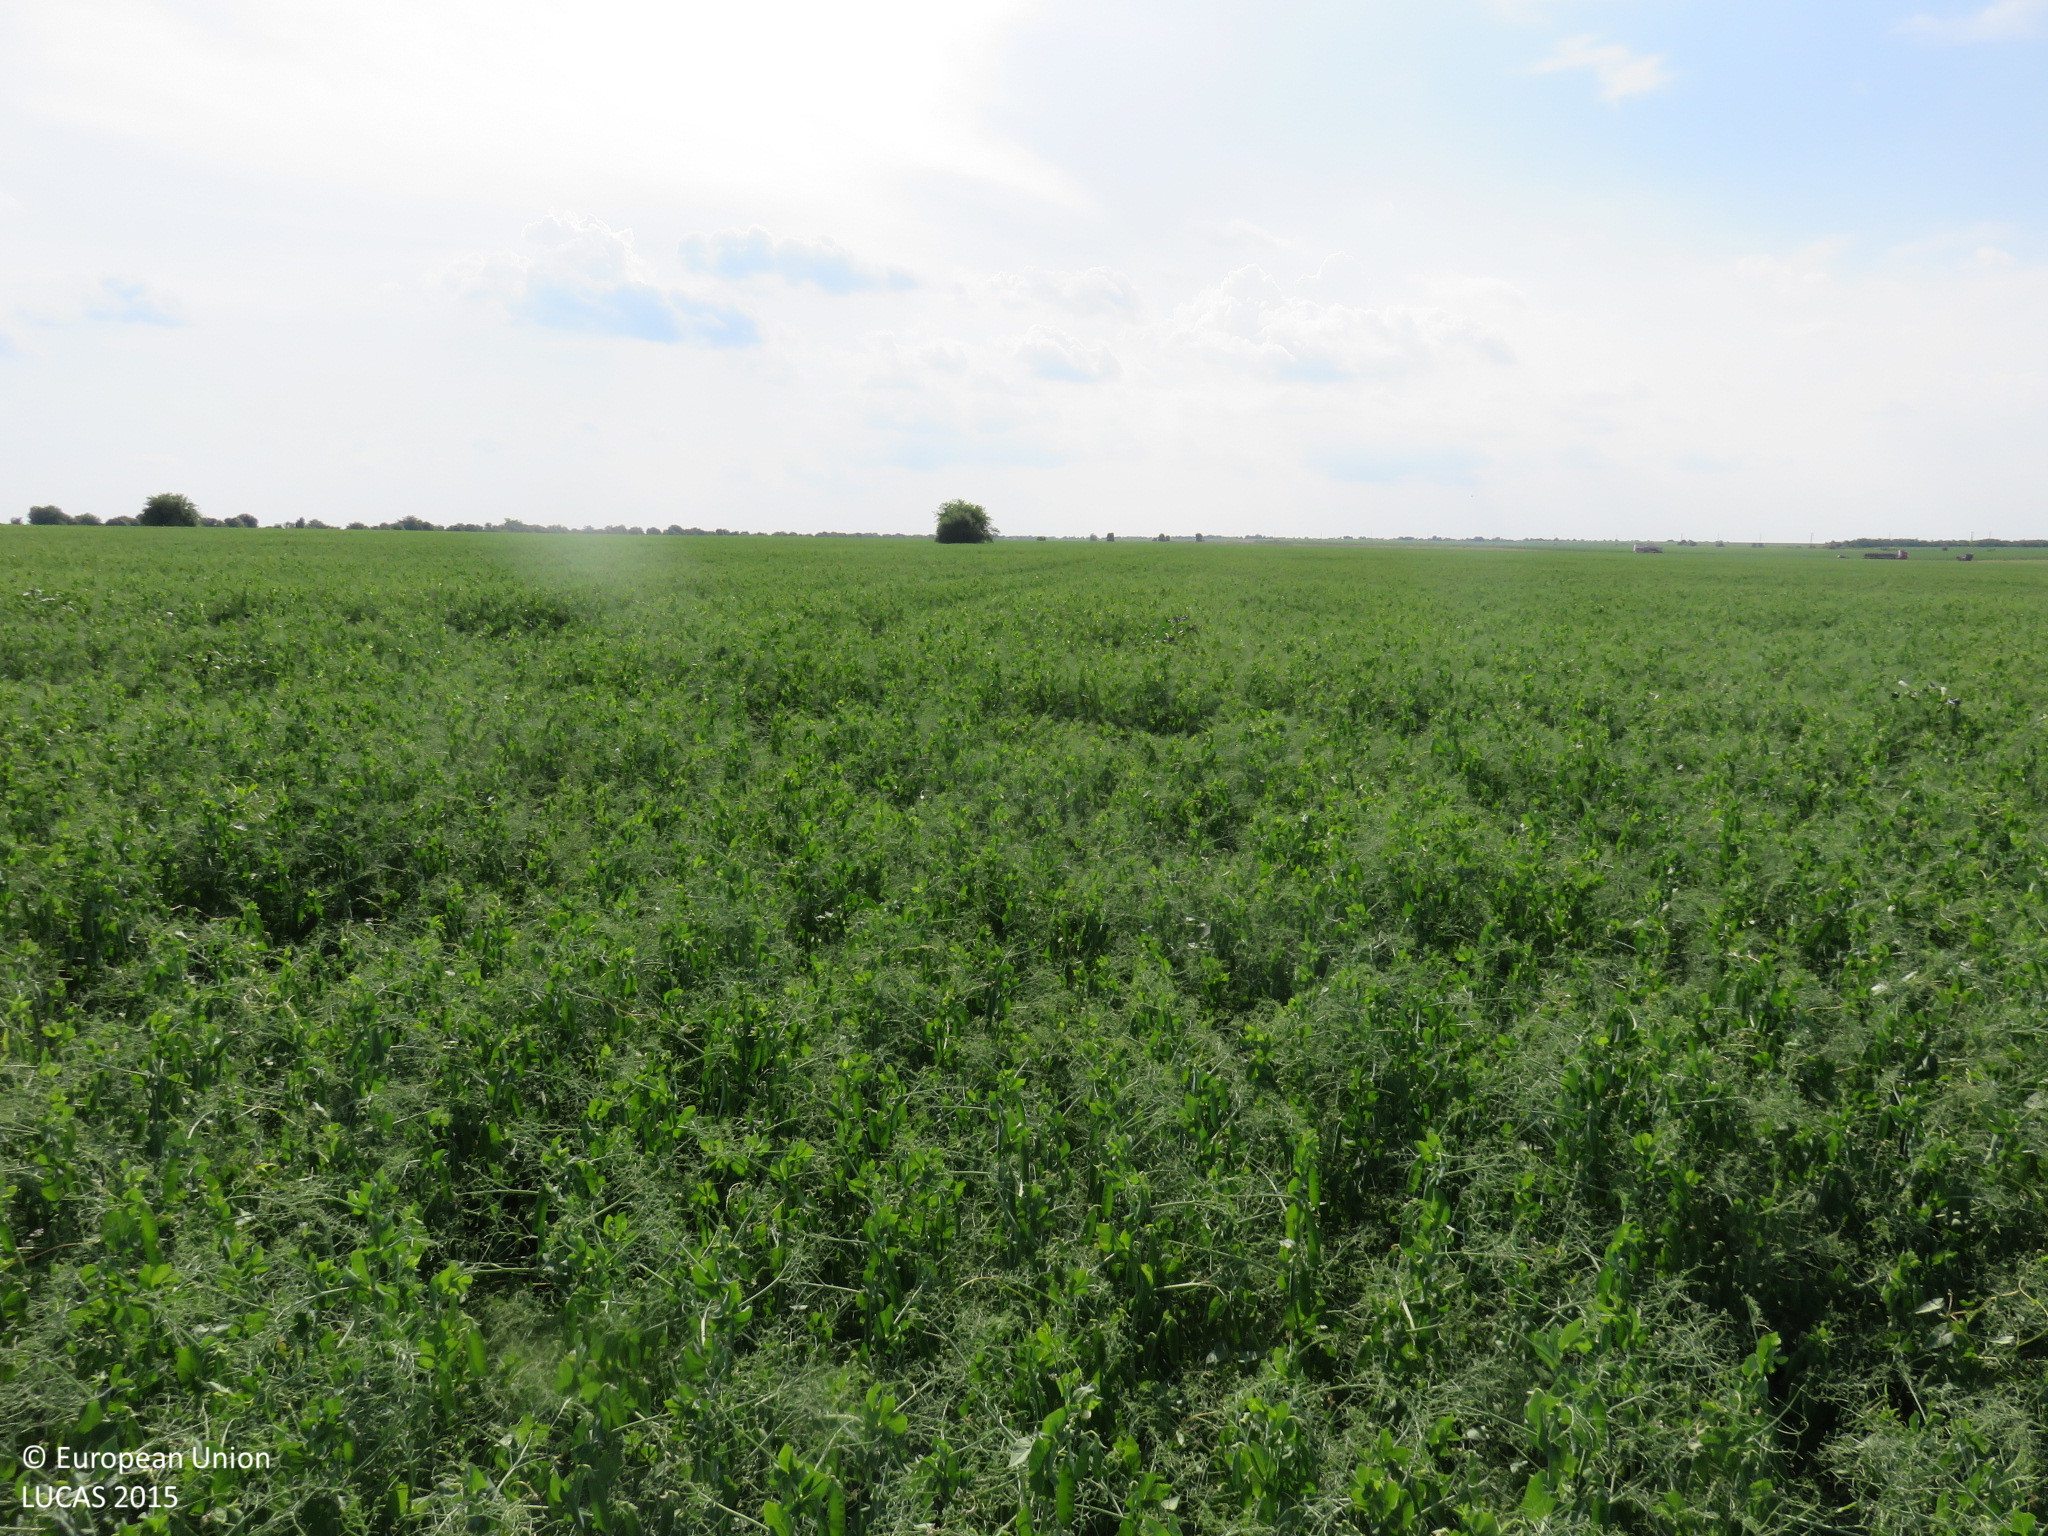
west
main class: Cropland
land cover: Dry pulses
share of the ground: > 75 %
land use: Agriculture (excluding fallow land and kitchen gardens)
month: June
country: BG
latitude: 43.4490
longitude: 24.4060
